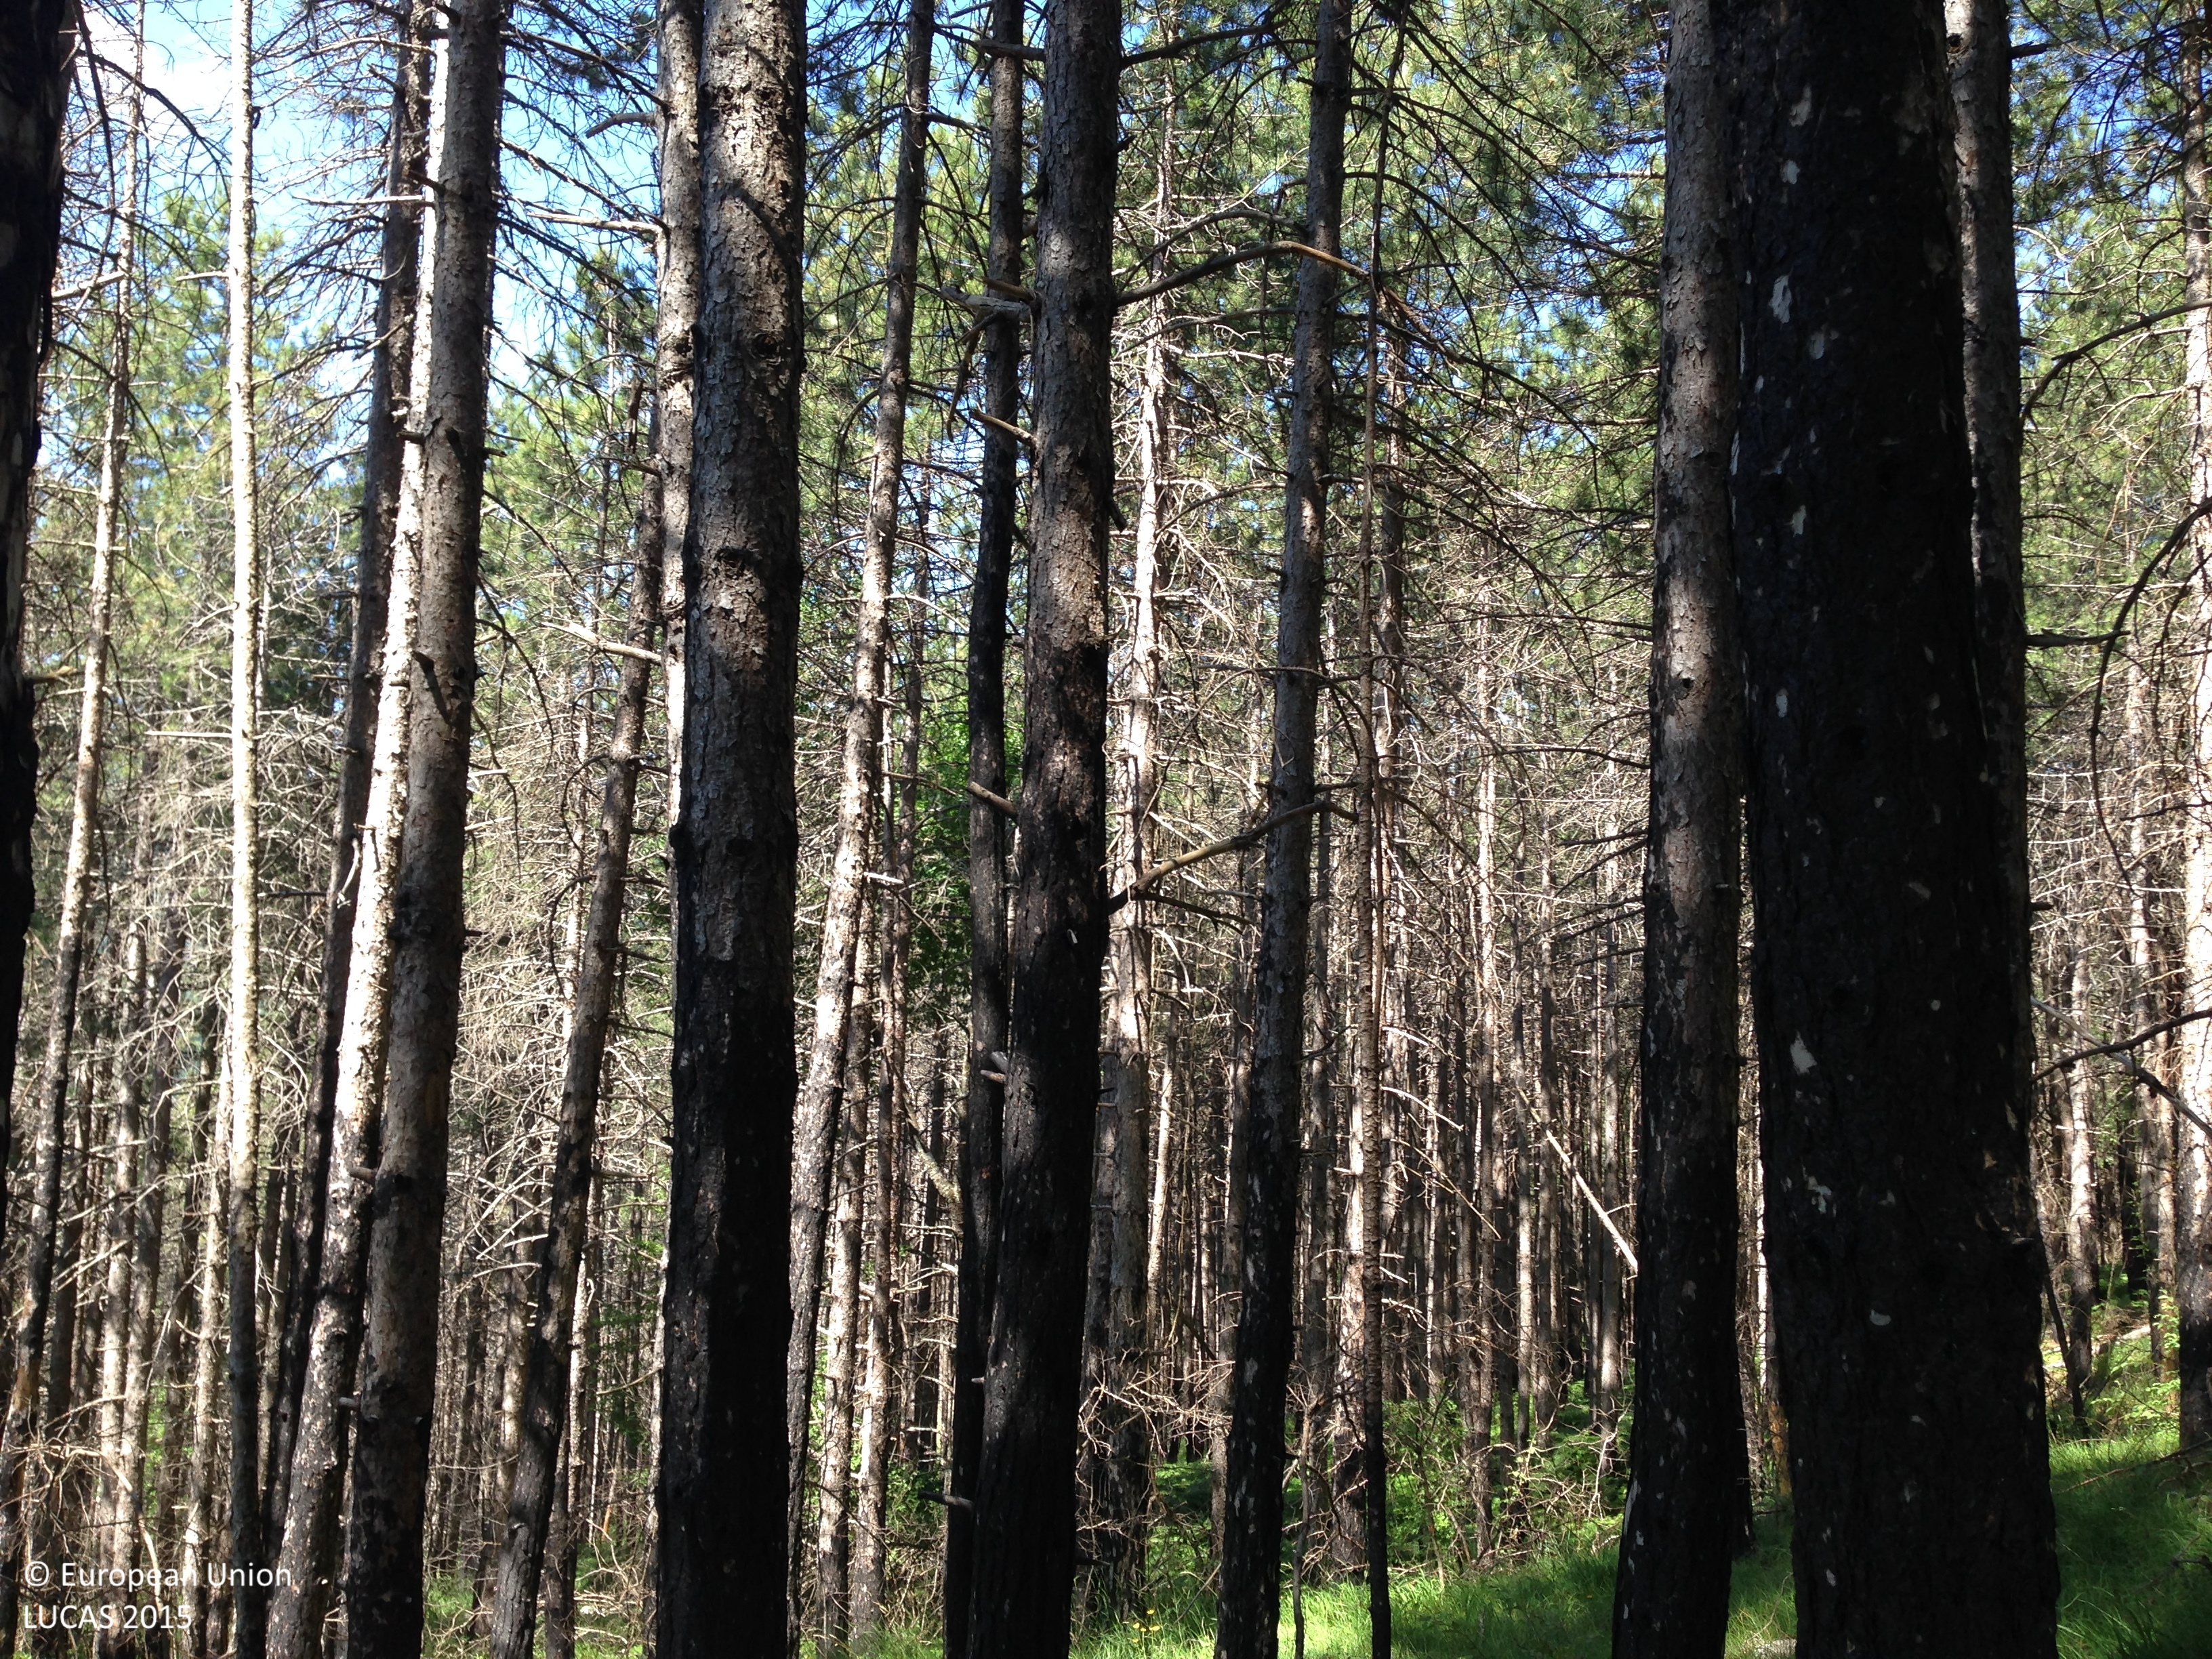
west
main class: Woodland
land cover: Pine dominated coniferous woodland
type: coniferous forest of the mediterranean region
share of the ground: > 75 %
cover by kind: coniferous forest trees 45 %, herbaceous plants 20 %, broadleaved forest trees 15 %, shrubs 5 %, lichens and mosses 5 %, consolidated bare surface 5 %, unconsolidated bare surface 5 %
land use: Forestry
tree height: > 5 m
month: July
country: HR
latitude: 44.6742
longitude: 15.1530
